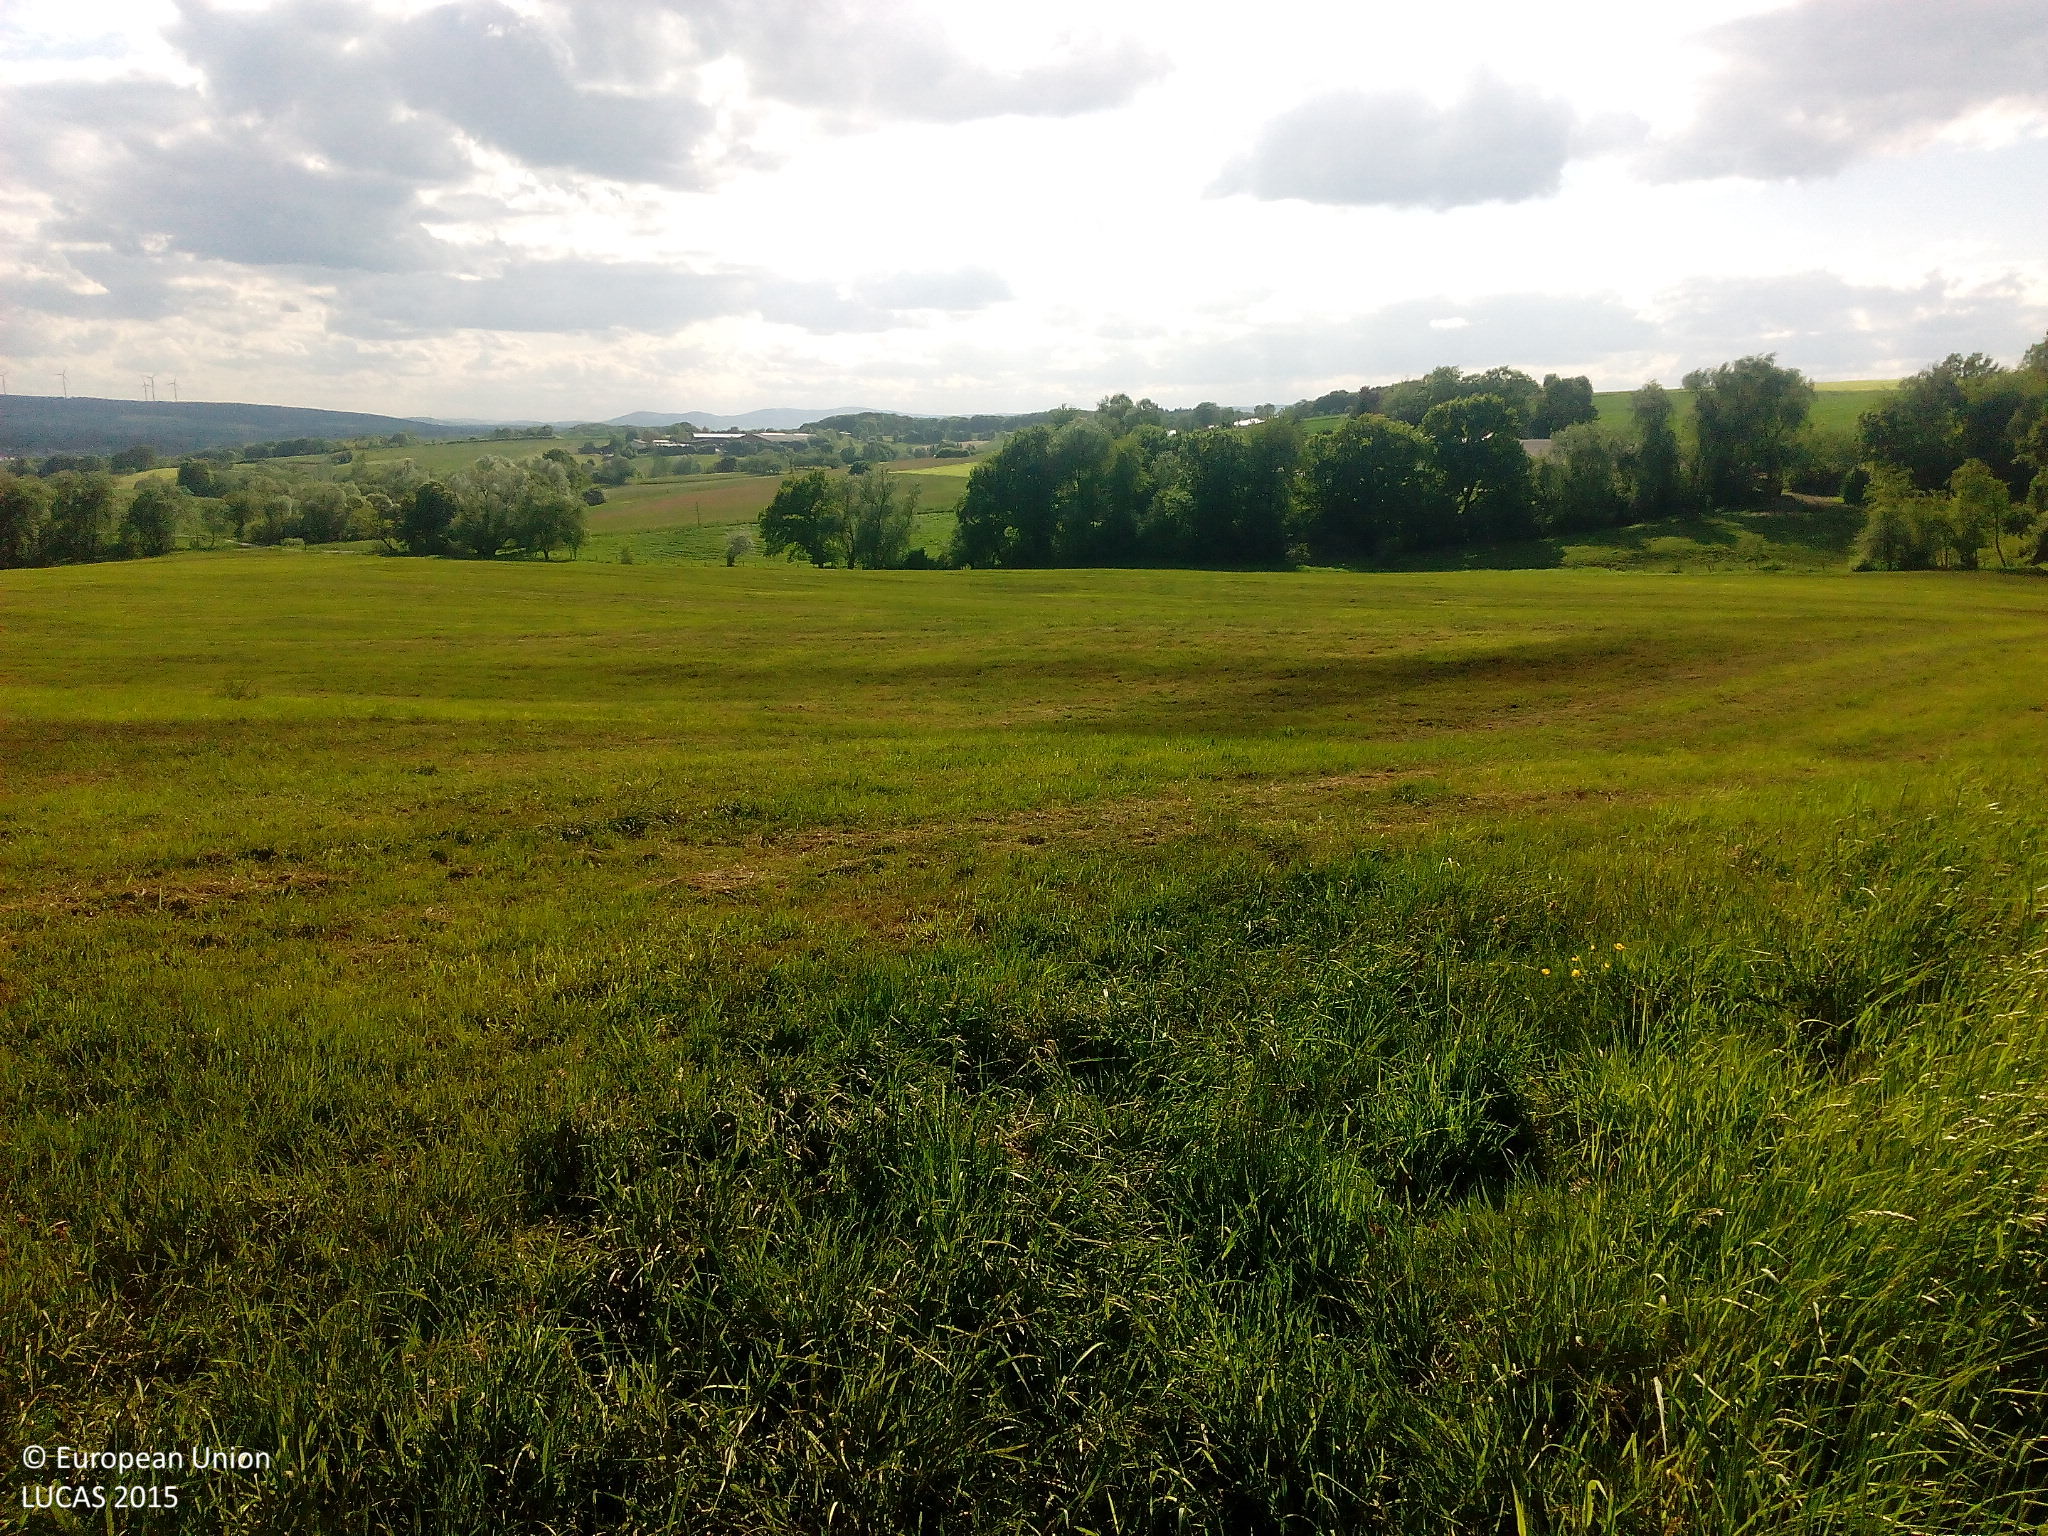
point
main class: Grassland
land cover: Grassland without tree/shrub cover
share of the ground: > 75 %
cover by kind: herbaceous plants 100 %
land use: Agriculture (excluding fallow land and kitchen gardens)
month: May
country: DE
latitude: 51.2984
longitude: 9.6416
